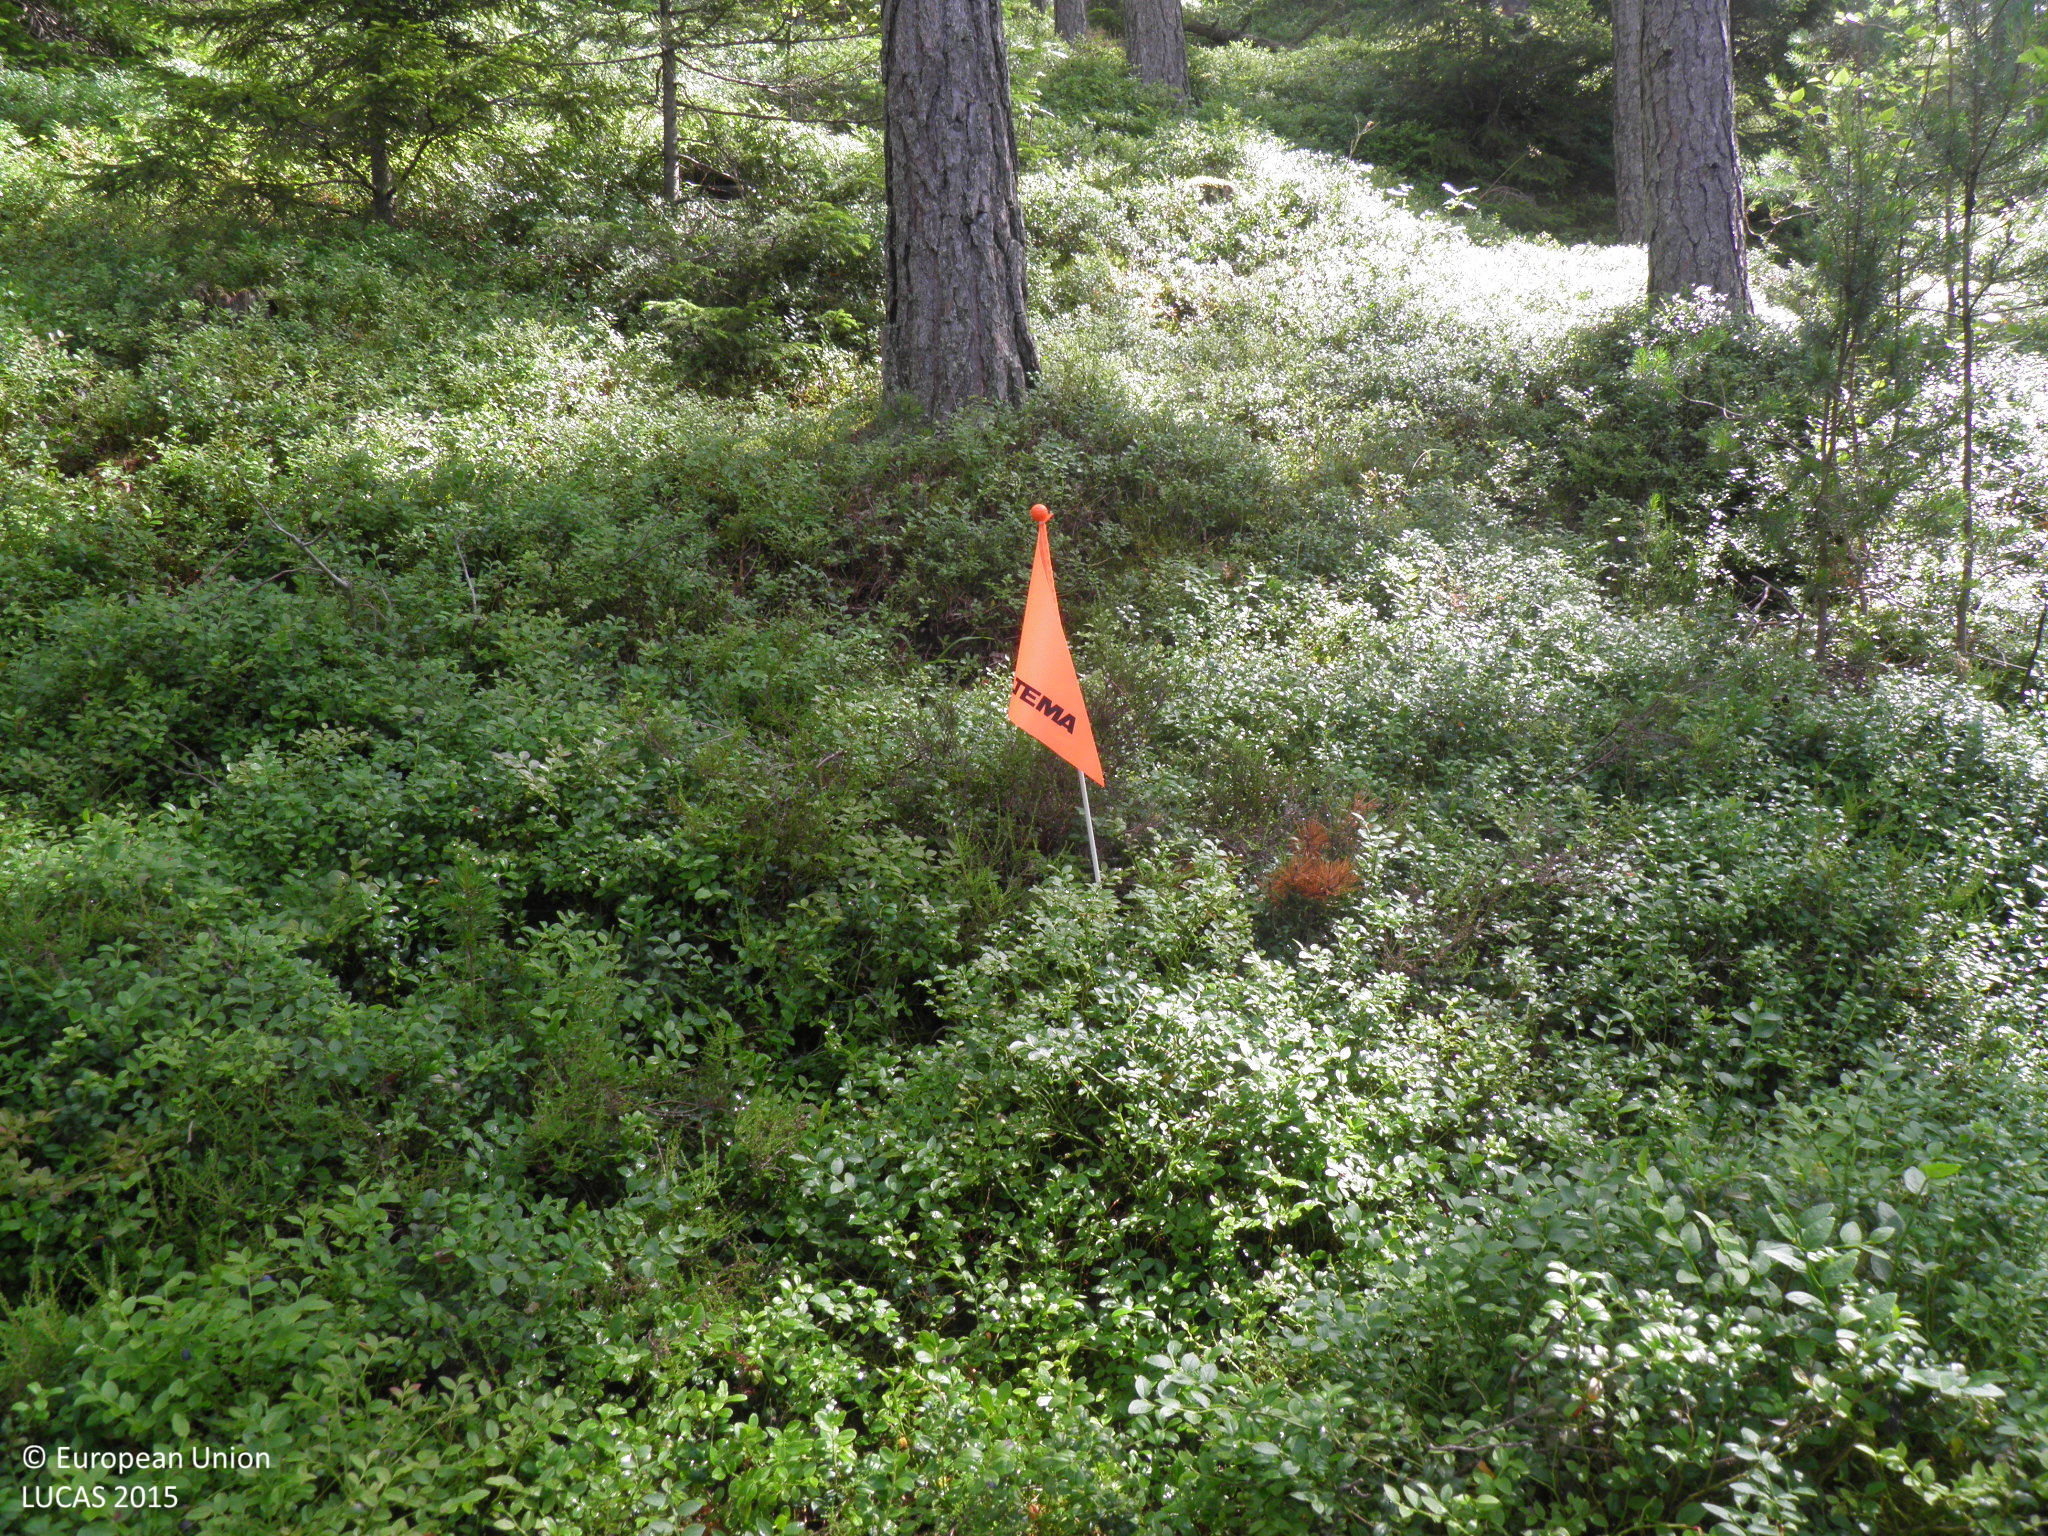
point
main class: Woodland
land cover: Pine dominated coniferous woodland
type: hemiboreal forest and nemoral coniferous forest and mixed broadleaved-coniferous forest
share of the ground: > 75 %
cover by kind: coniferous forest trees 70 %, shrubs 20 %, broadleaved forest trees 10 %
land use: Forestry
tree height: > 5 m
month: July
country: FI
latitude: 60.0500
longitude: 22.4083
